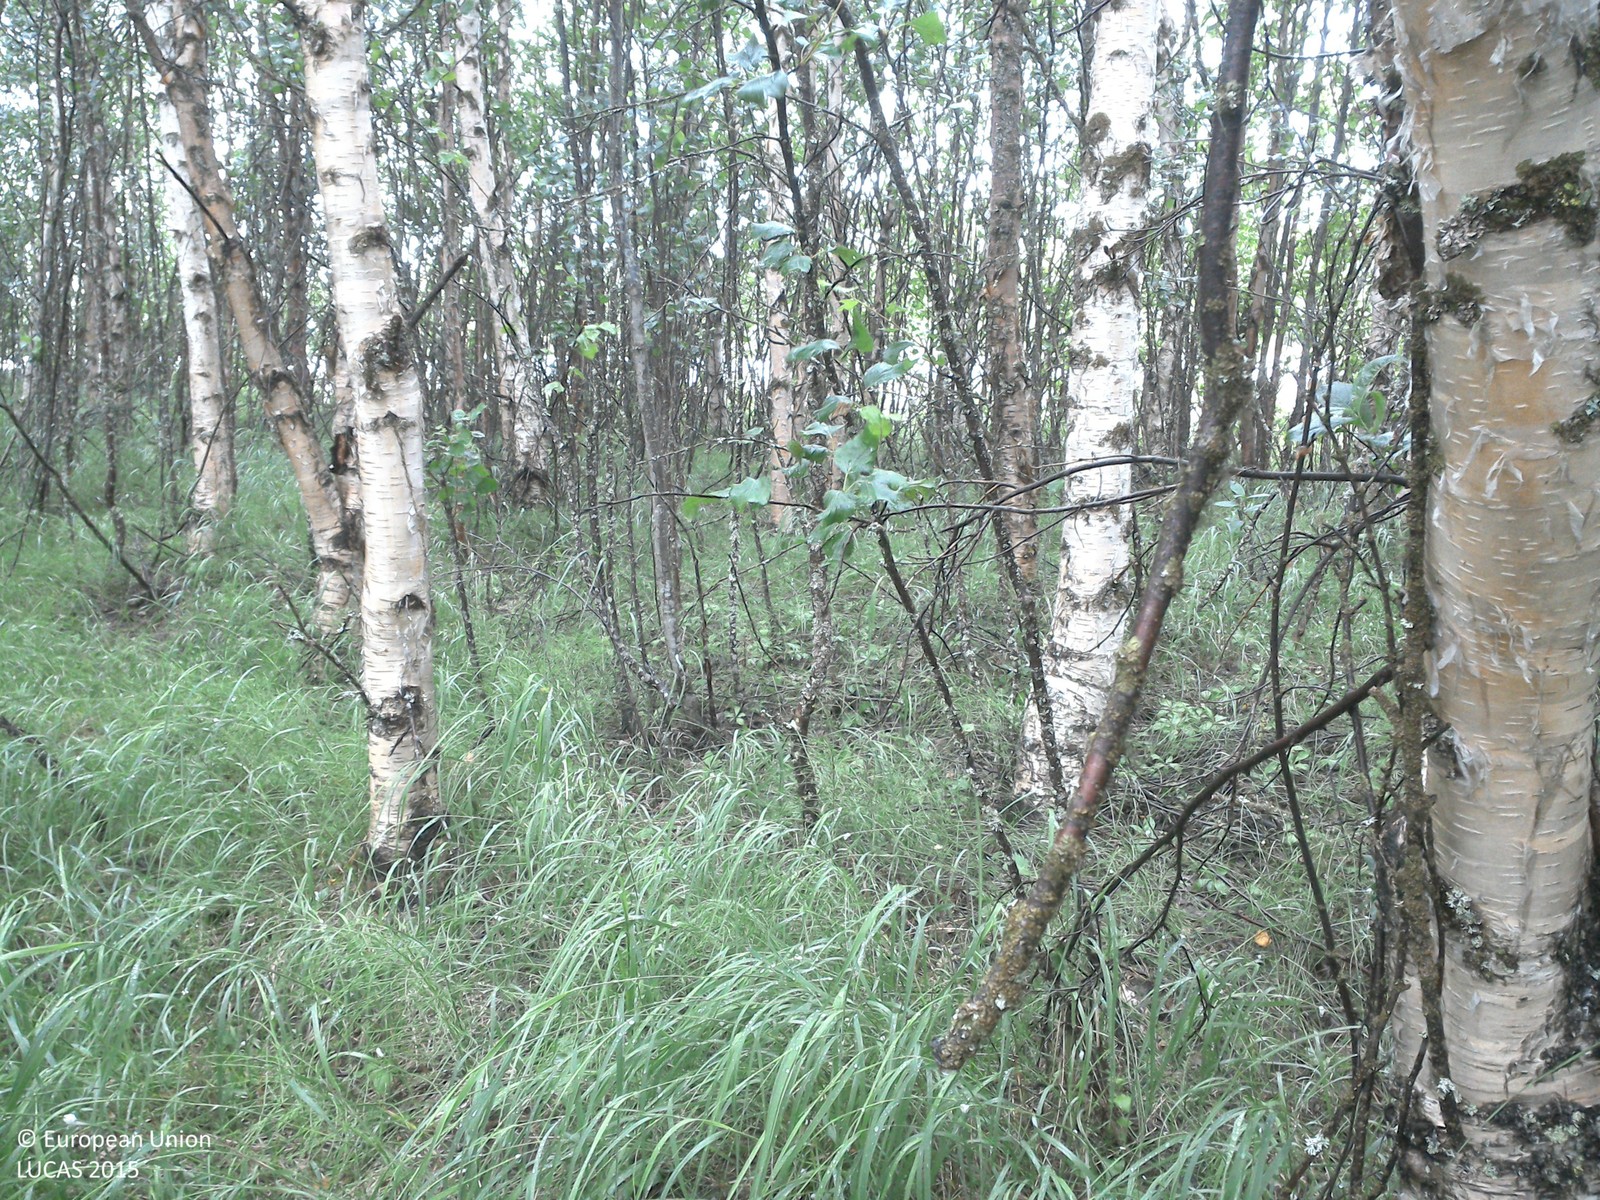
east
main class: Woodland
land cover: Broadleaved woodland
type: boreal forest
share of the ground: 50 - 75 %
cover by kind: broadleaved forest trees 60 %, herbaceous plants 40 %
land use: Forestry
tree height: > 5 m
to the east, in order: Broadleaved woodland; Grass margins; Ditches and canals; Rocks and stones; Paved roads, cycling and walking lanes; Rocks and stones; Ditches and canals; Shrubland without tree cover; Electric lines; Groves; Broadleaved woodland; Electric lines; Broadleaved woodland; Ditches and canals; Broadleaved woodland; Grassland with sparse tree/shrub cover; Broadleaved woodland; Ditches and canals; Broadleaved woodland; Ditches and canals; Broadleaved woodland
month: July
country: SE
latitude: 67.6720
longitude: 21.6238
